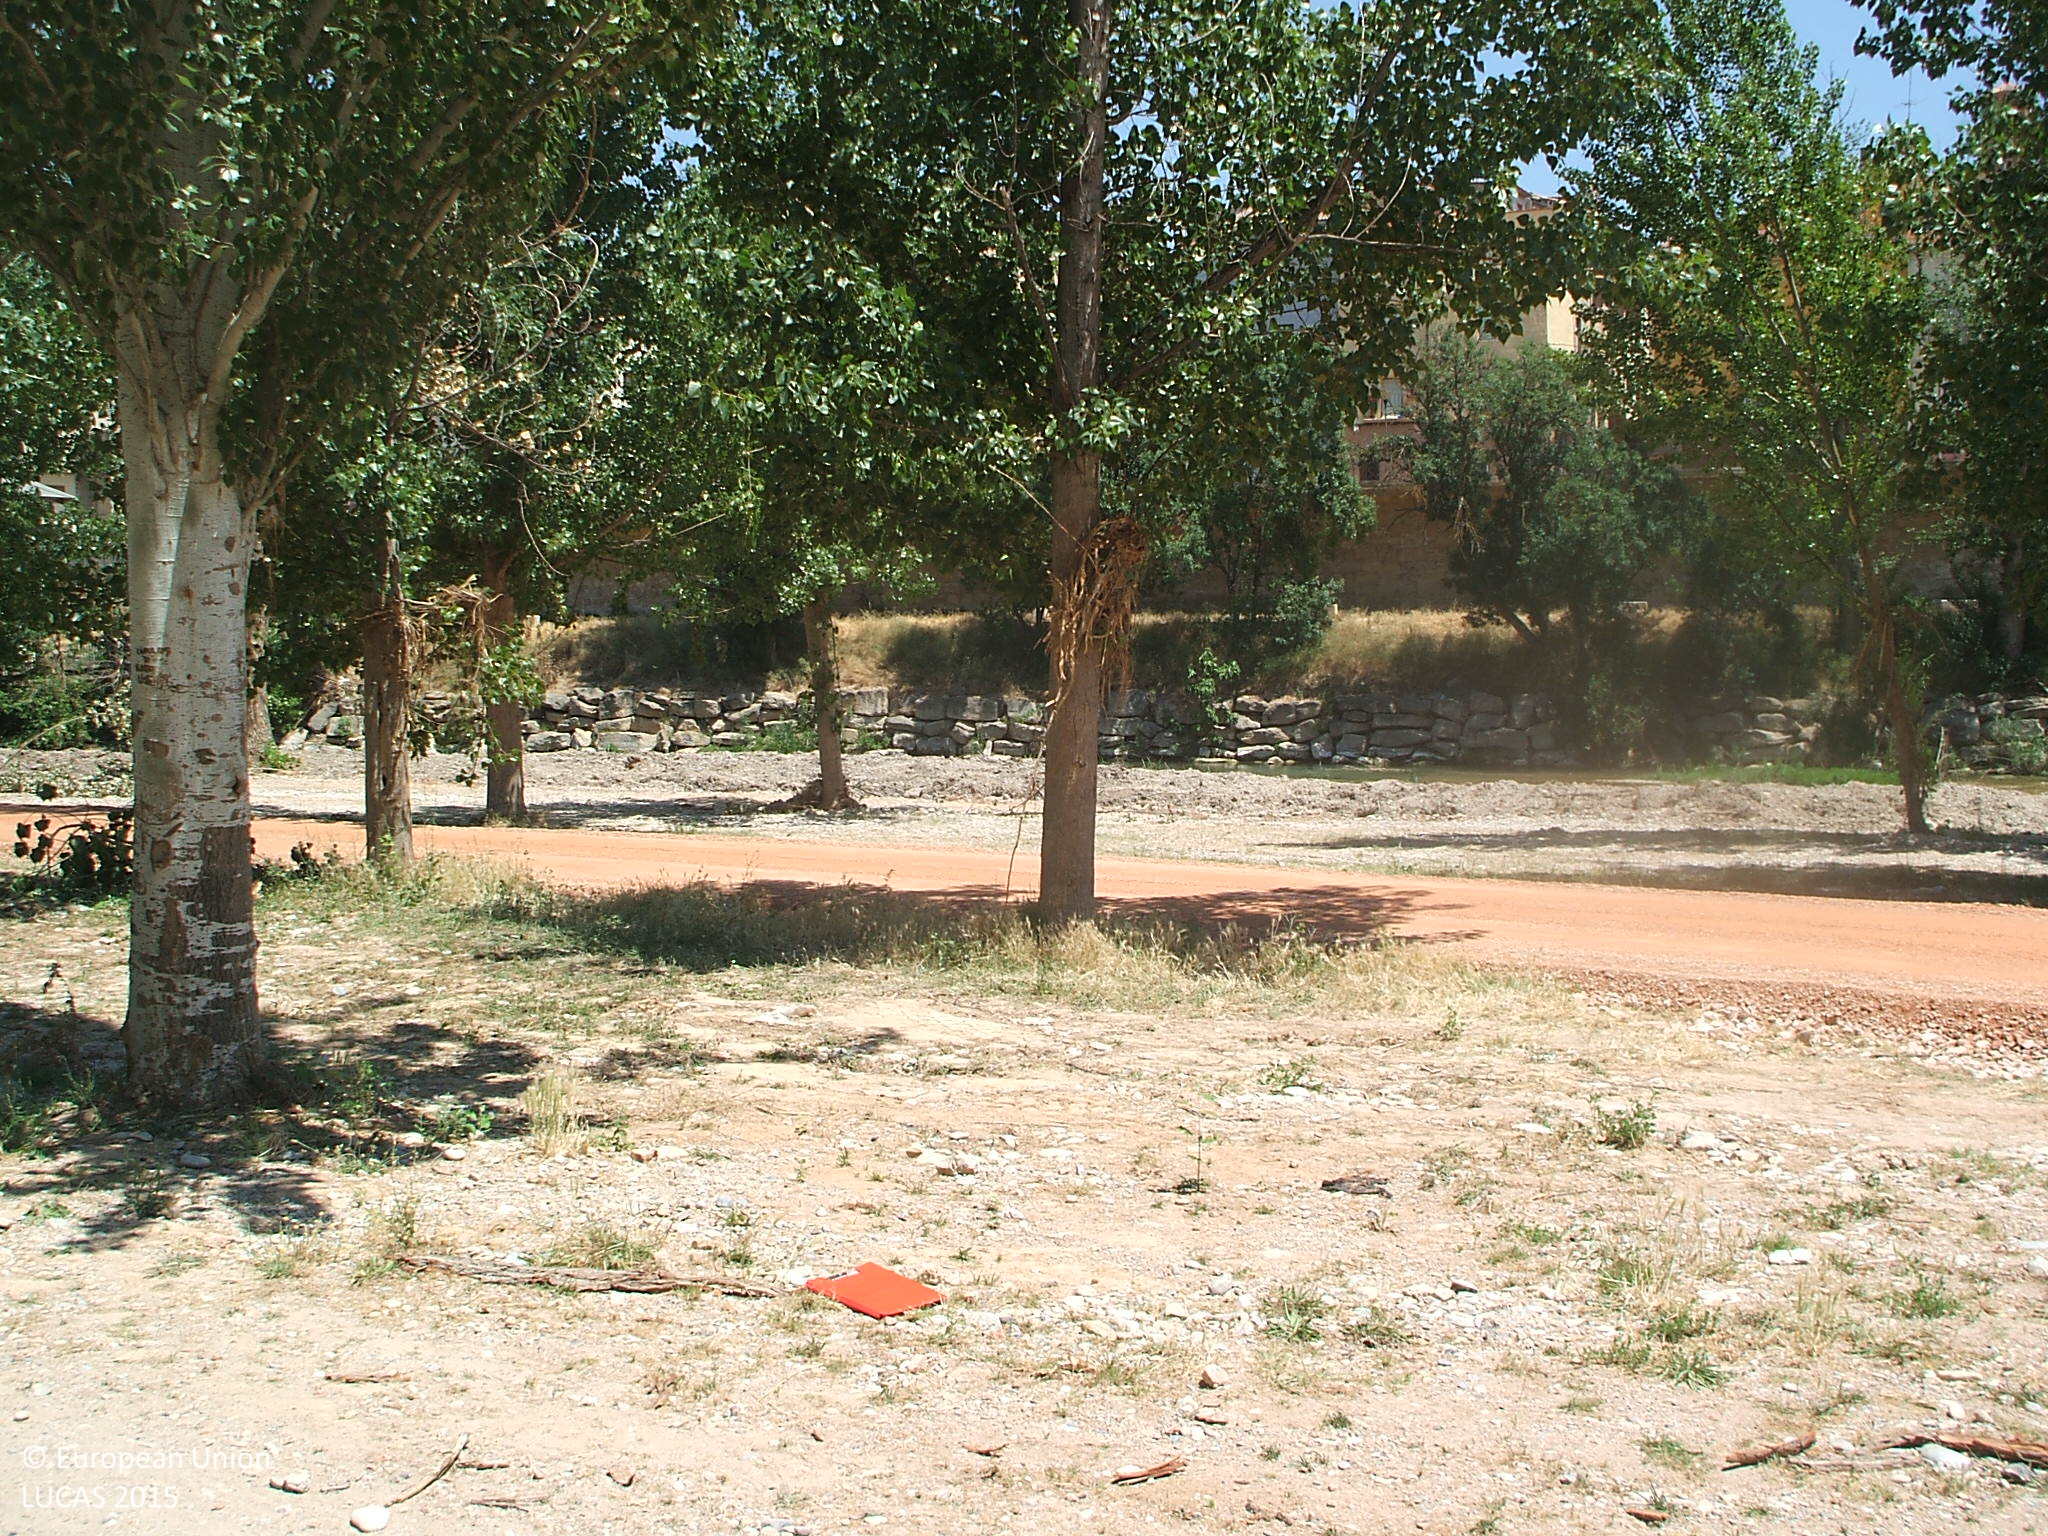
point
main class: Woodland
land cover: Broadleaved woodland
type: exotic forest
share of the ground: 50 - 75 %
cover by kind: broadleaved forest trees 60 %, unconsolidated bare surface 30 %, herbaceous plants 10 %
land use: Amenities, museums, leisure
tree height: > 5 m
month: June
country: ES
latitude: 41.0524
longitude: -0.1366
